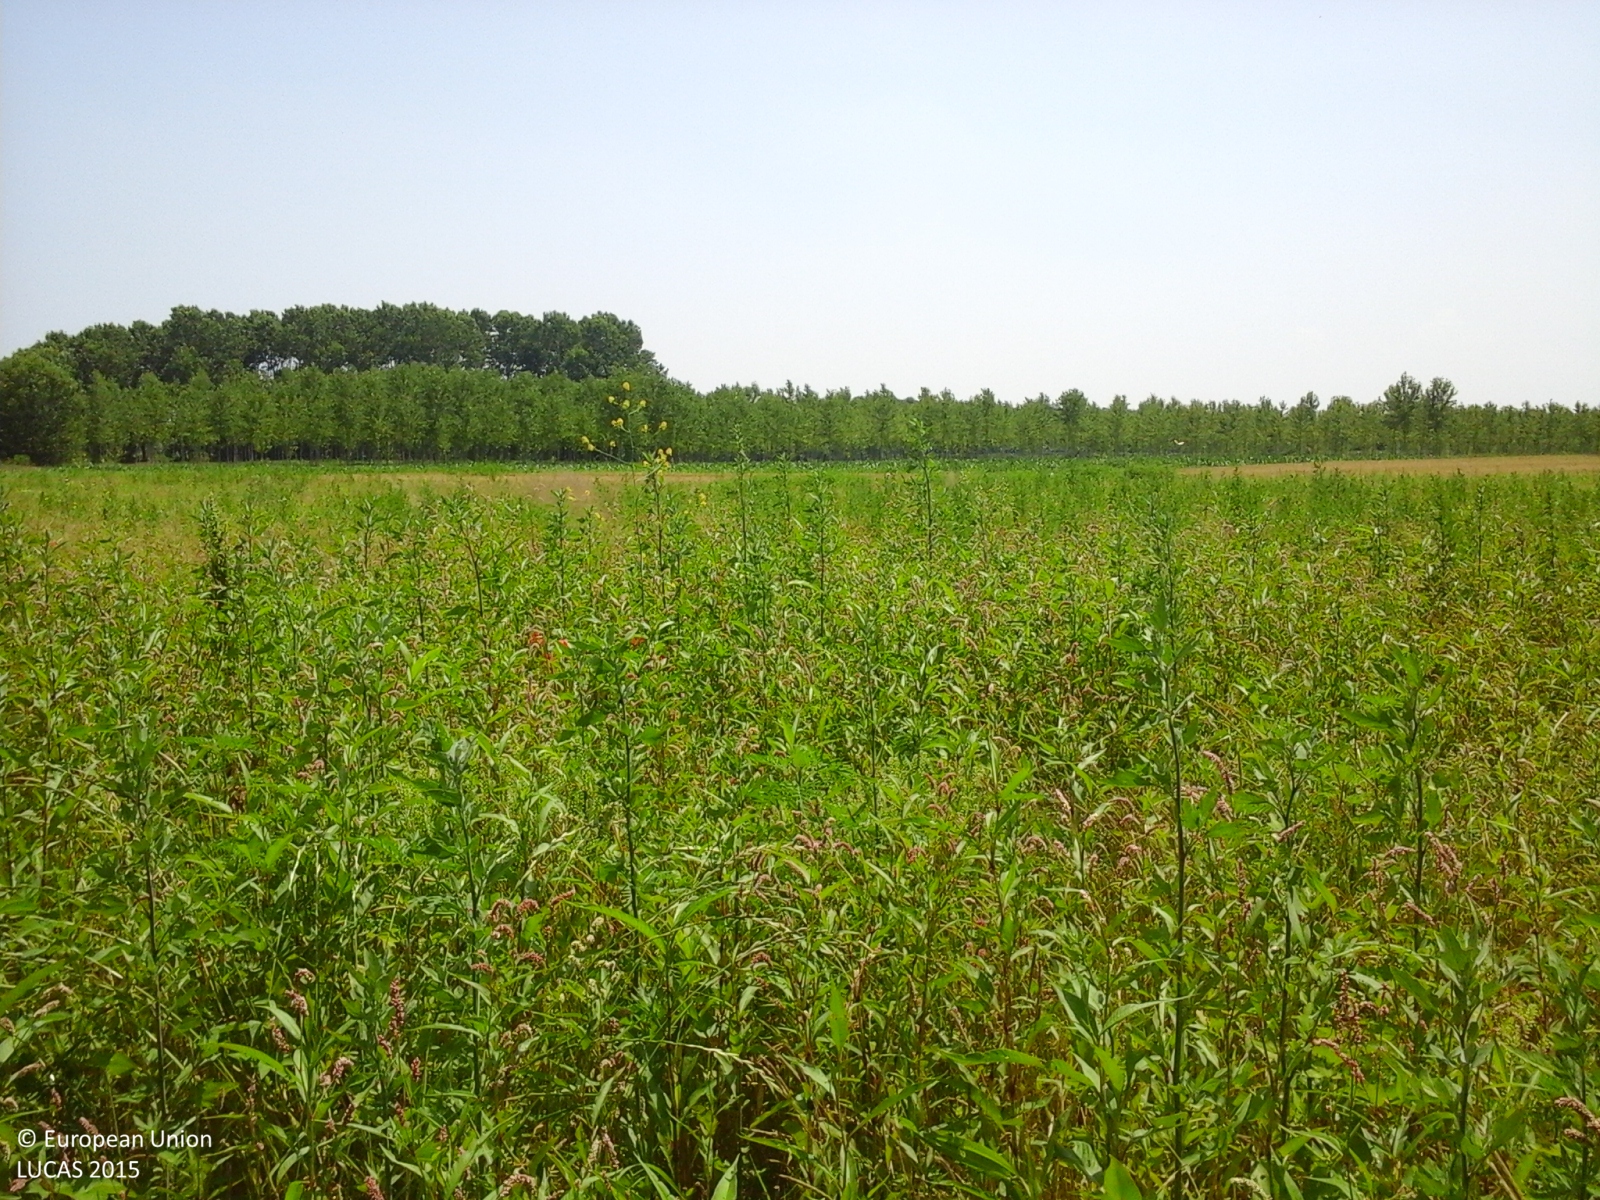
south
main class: Grassland
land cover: Spontaneously vegetated surfaces
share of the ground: > 75 %
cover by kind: herbaceous plants 100 %
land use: Fallow land
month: June
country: IT
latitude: 45.1078
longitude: 9.8858
